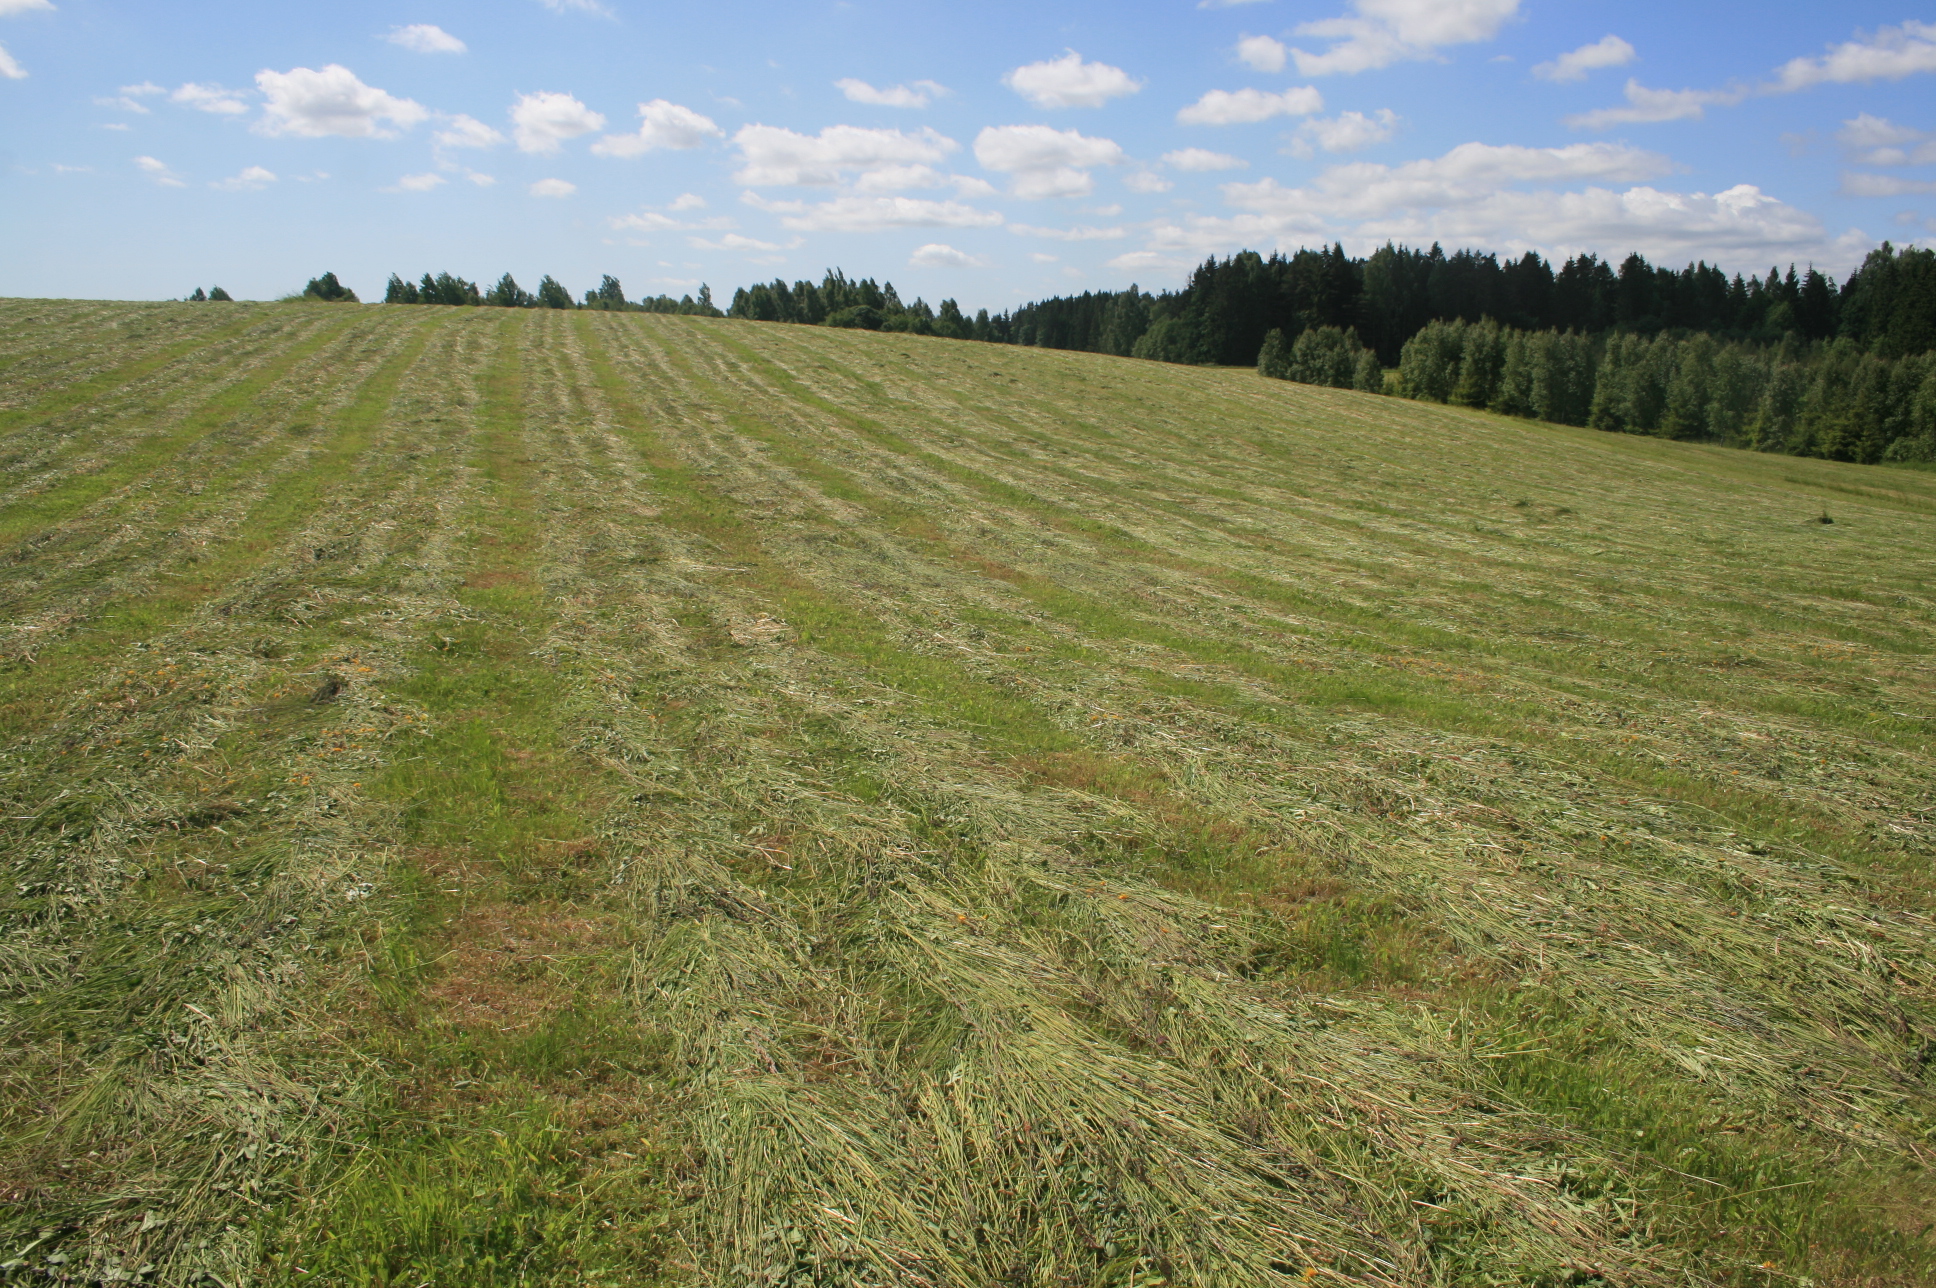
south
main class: Grassland
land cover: Grassland without tree/shrub cover
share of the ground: > 75 %
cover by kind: herbaceous plants 100 %
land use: Agriculture (excluding fallow land and kitchen gardens)
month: June
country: LT
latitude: 55.8506
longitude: 22.2755
